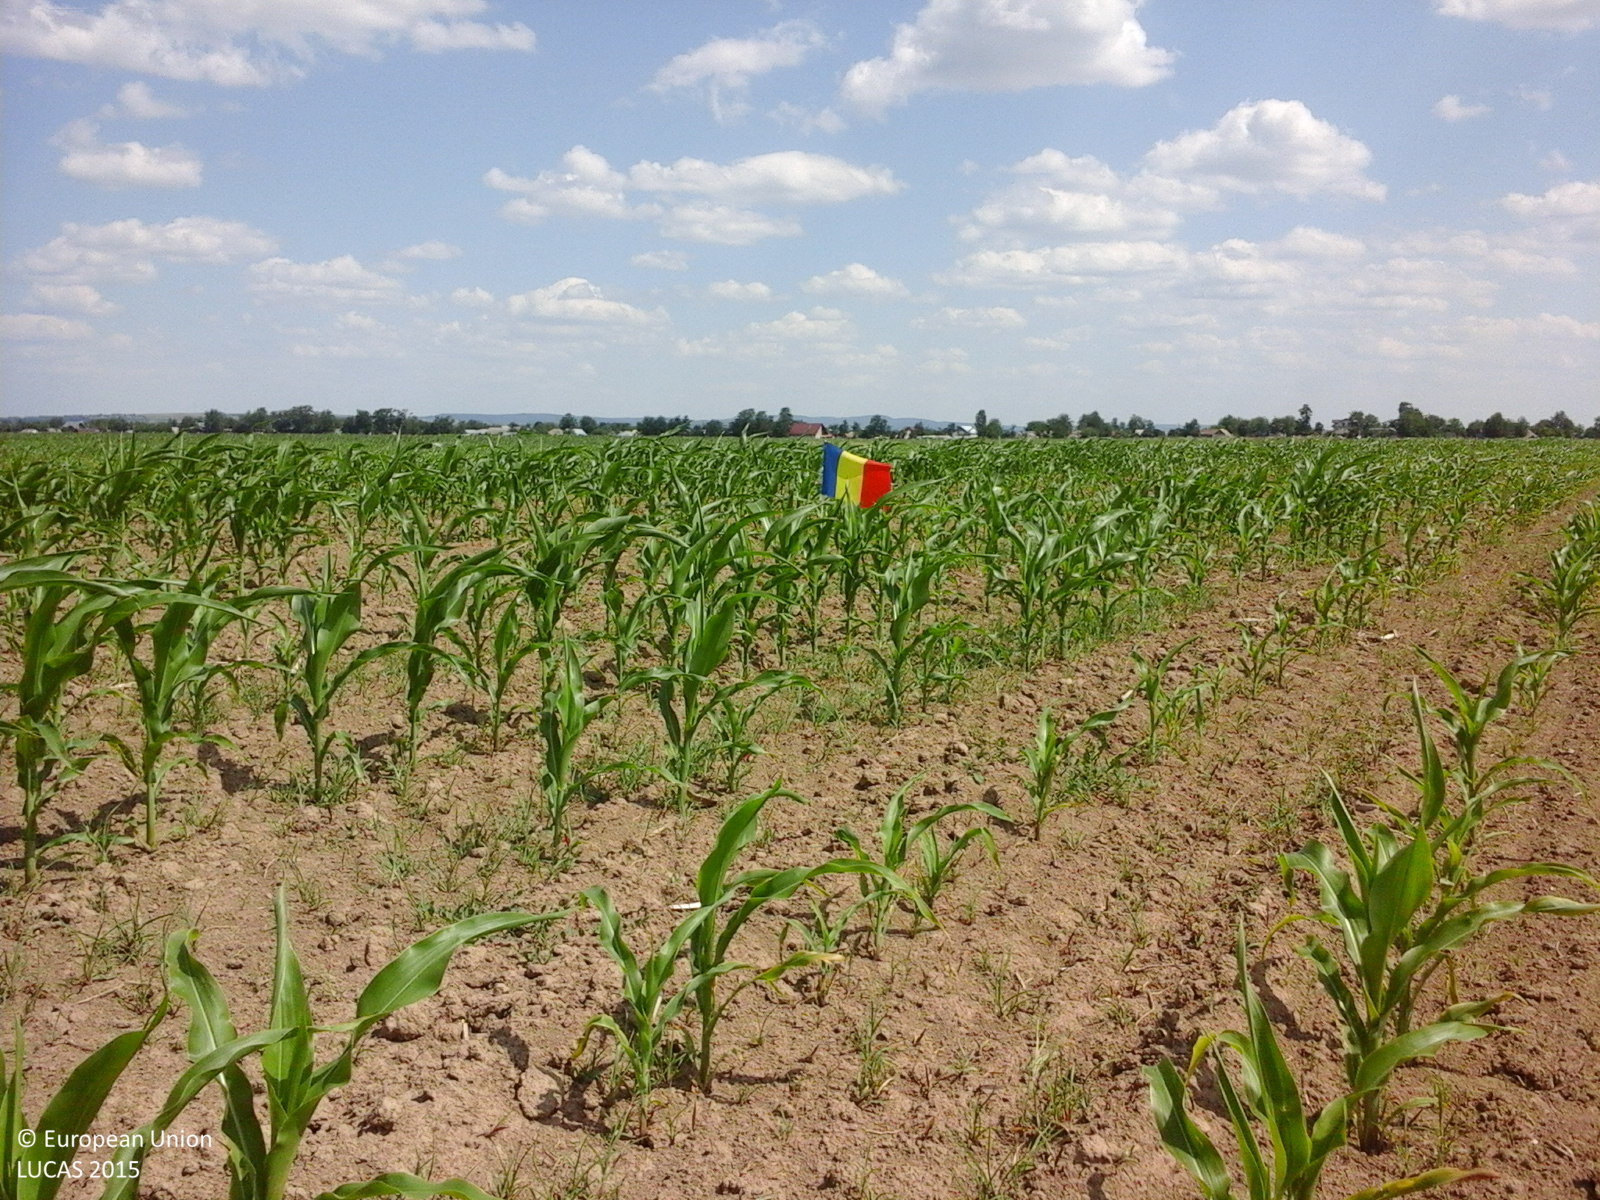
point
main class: Cropland
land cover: Maize
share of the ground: 25 - 50 %
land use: Agriculture (excluding fallow land and kitchen gardens)
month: June
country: RO
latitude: 47.6126
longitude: 26.4928
